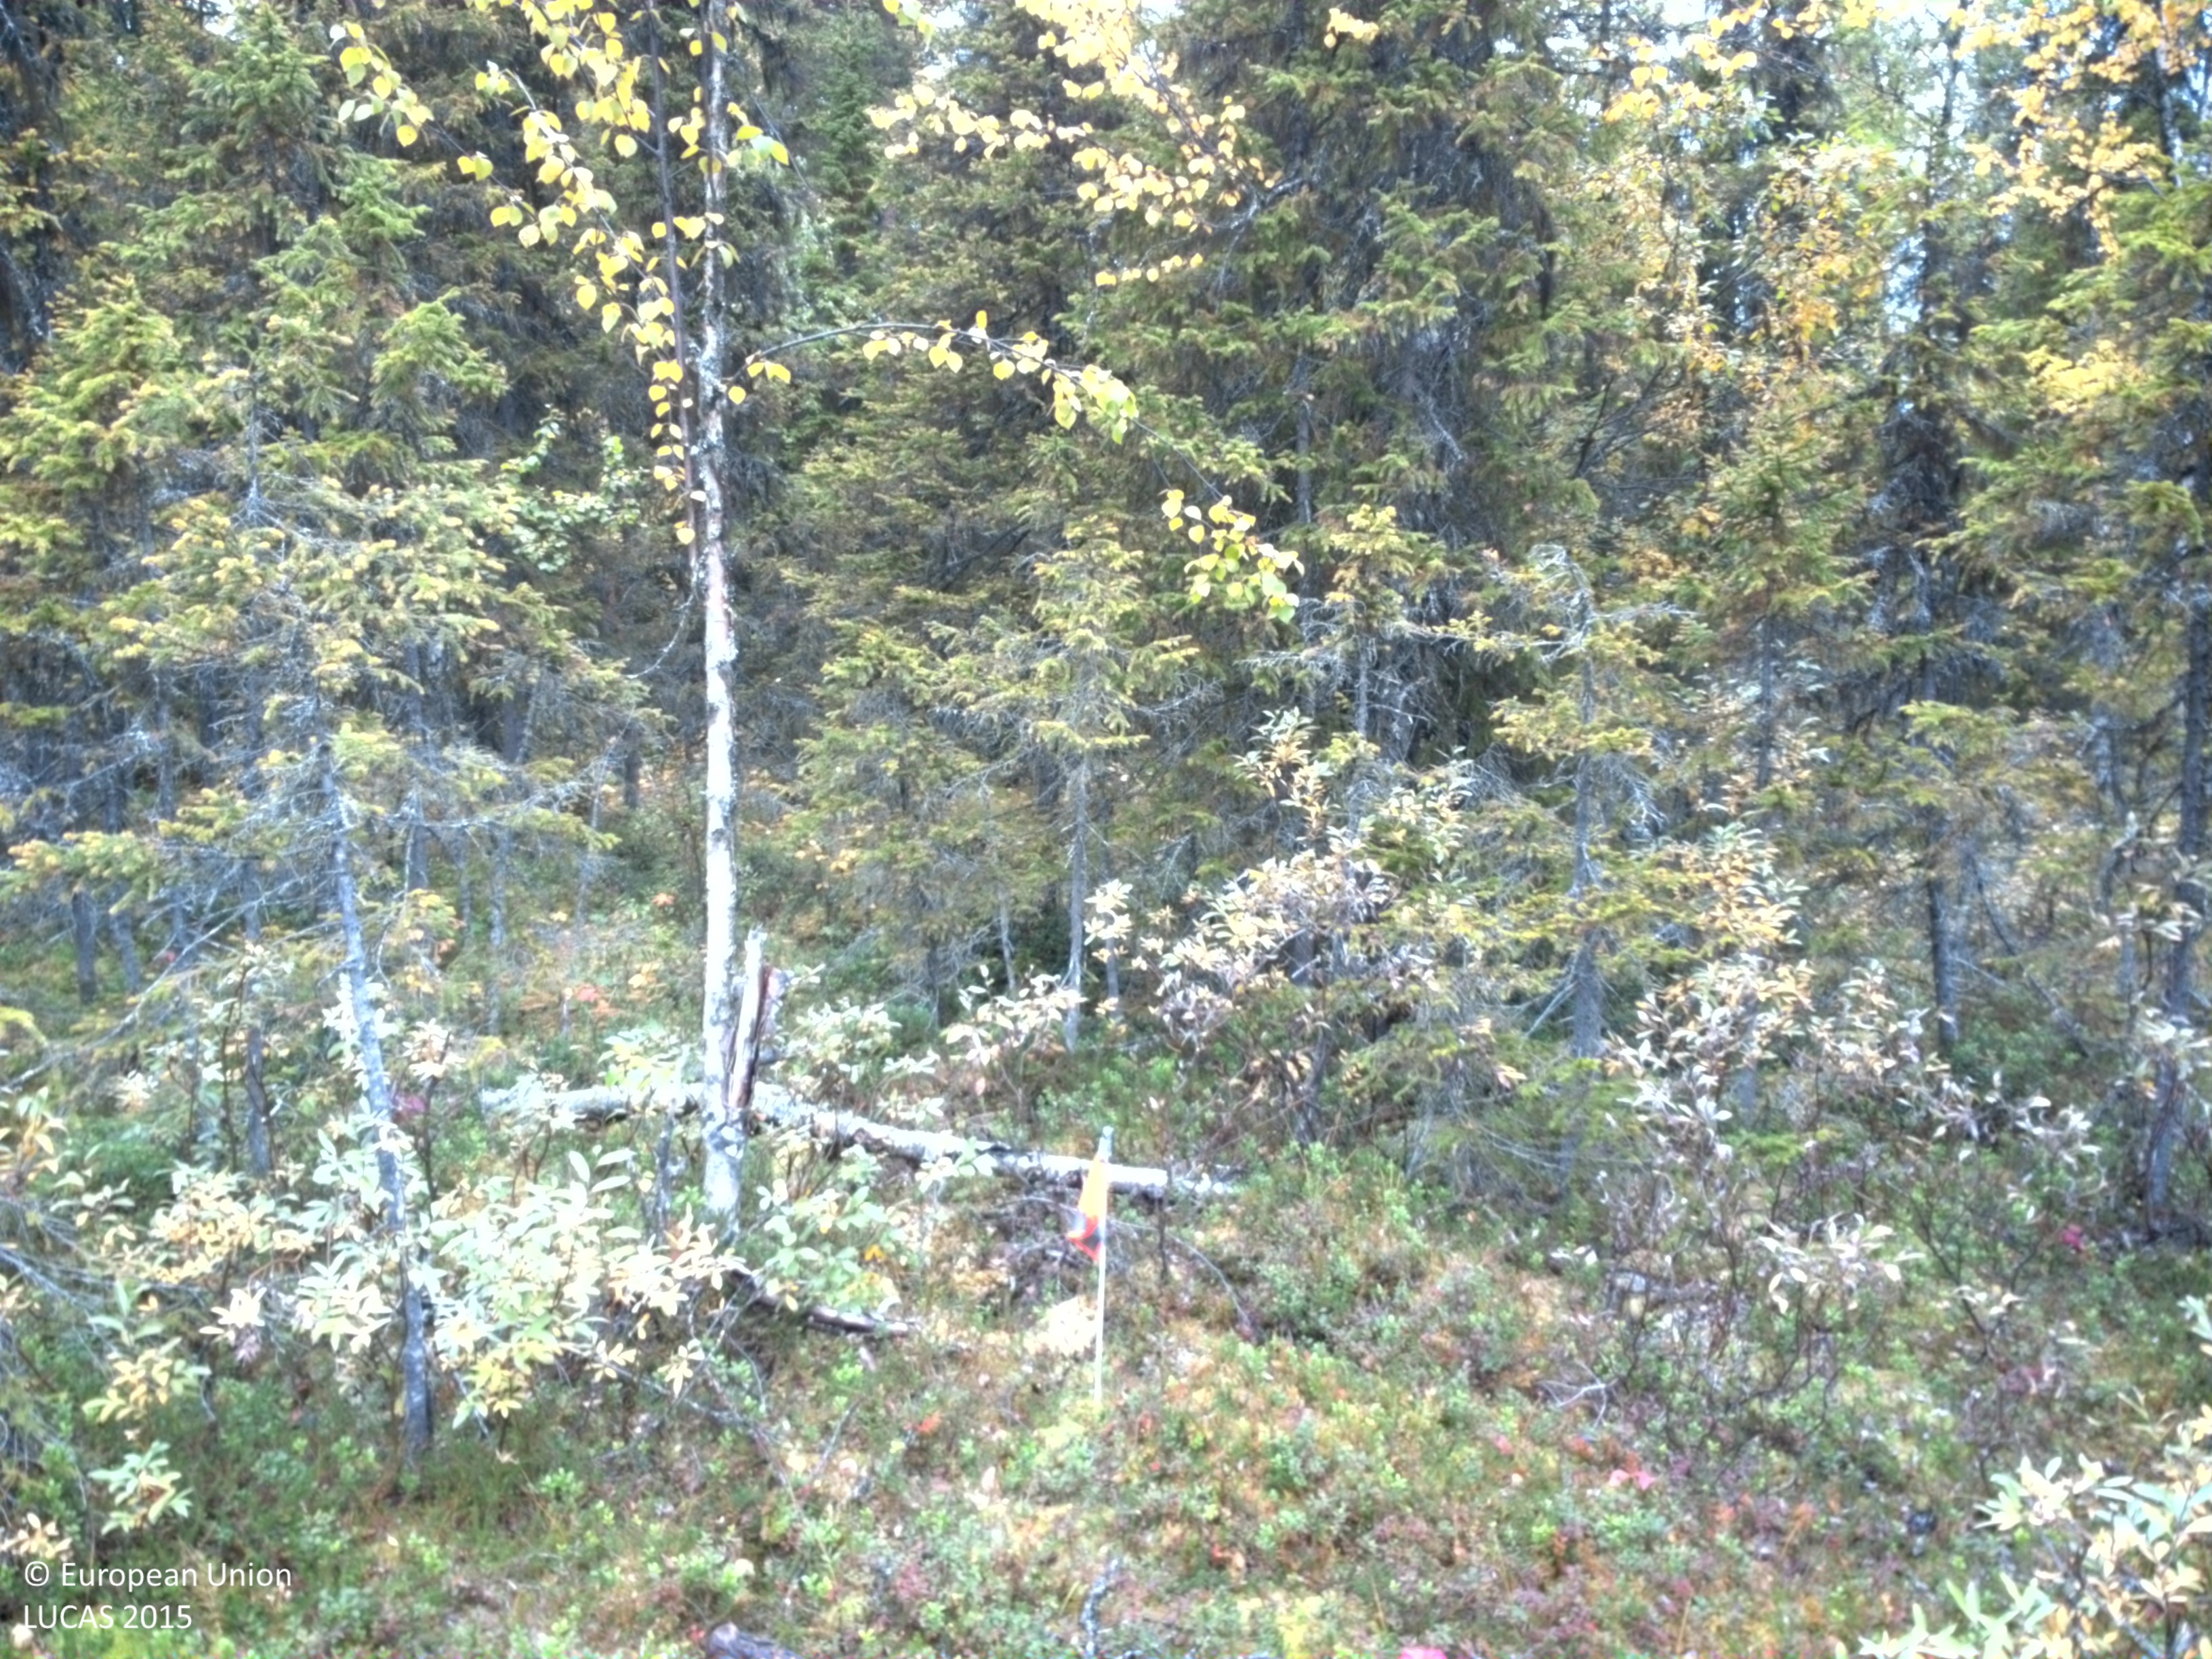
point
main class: Woodland
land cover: Spruce dominated coniferous woodland
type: boreal forest
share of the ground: 25 - 50 %
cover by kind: shrubs 40 %, coniferous forest trees 35 %, lichens and mosses 15 %, broadleaved forest trees 5 %, herbaceous plants 5 %
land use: Forestry
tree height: > 5 m
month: September
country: SE
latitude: 65.1176
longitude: 16.9284
